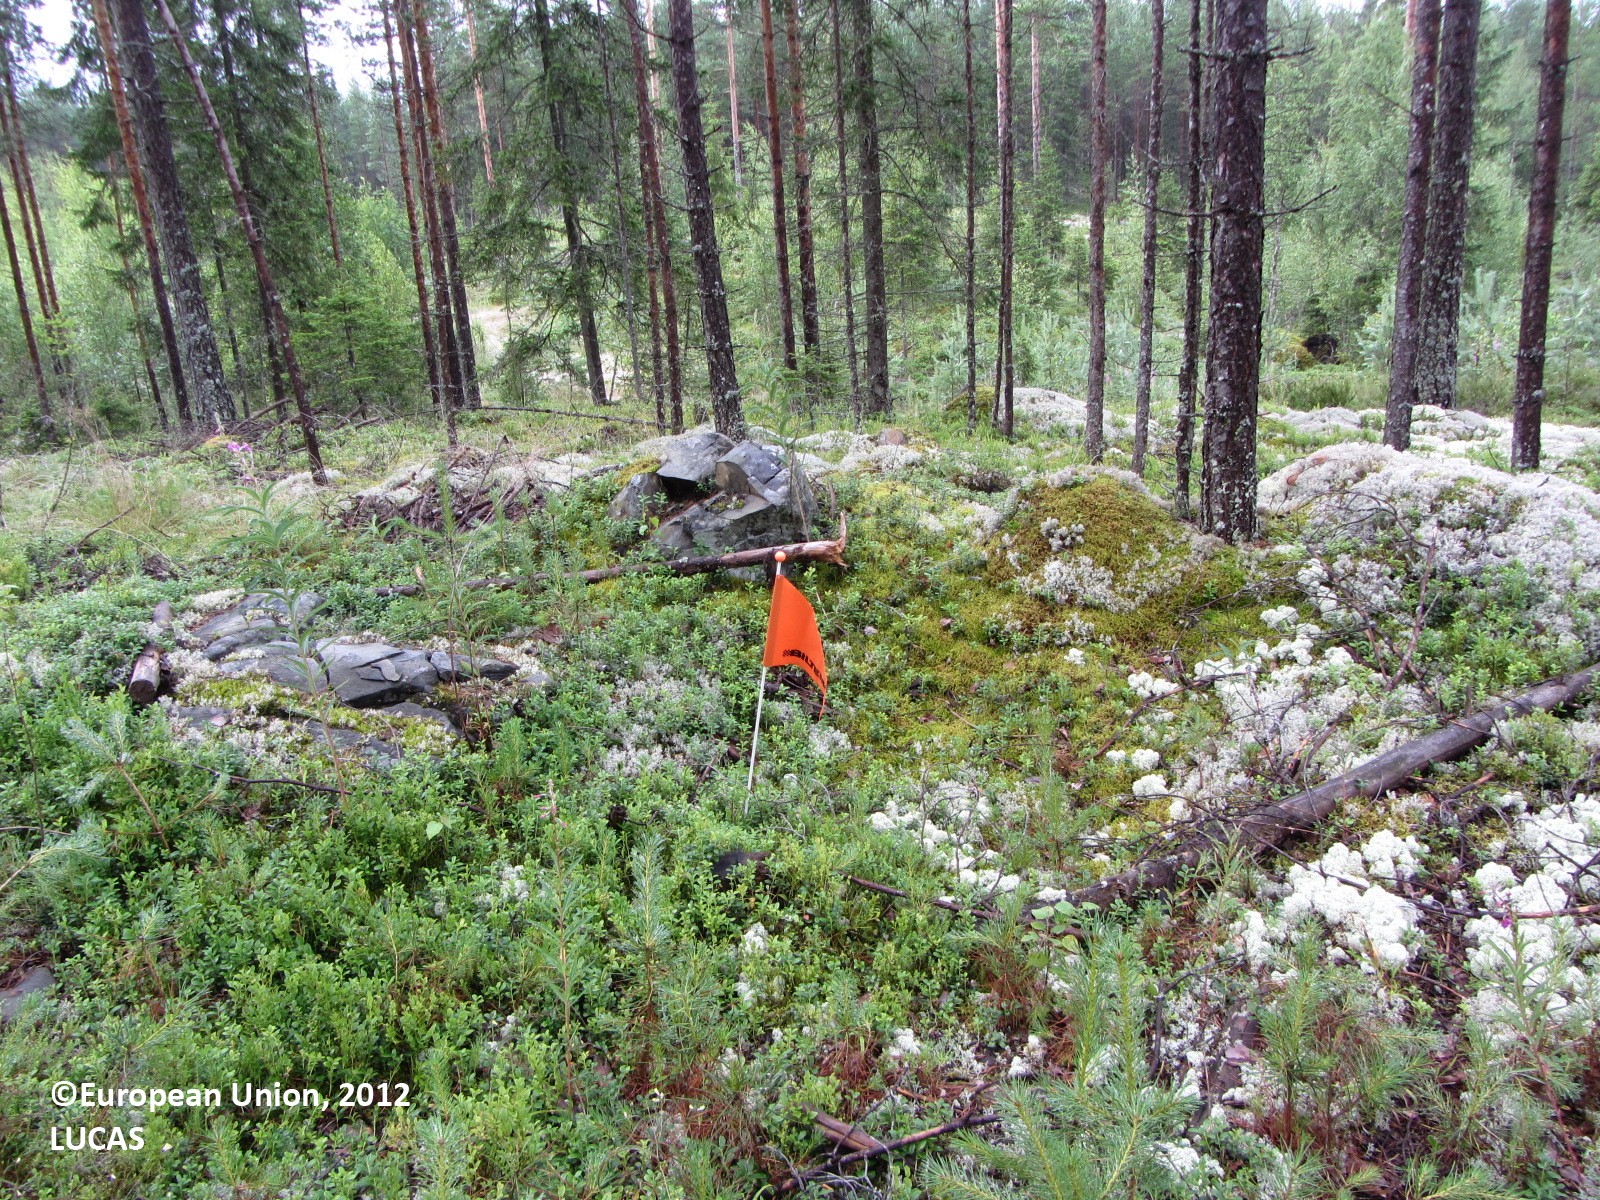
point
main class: Woodland
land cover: Pine dominated coniferous woodland
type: boreal forest
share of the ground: 50 - 75 %
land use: Forestry
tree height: > 5 m
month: July
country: FI
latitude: 63.9143
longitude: 24.8608
